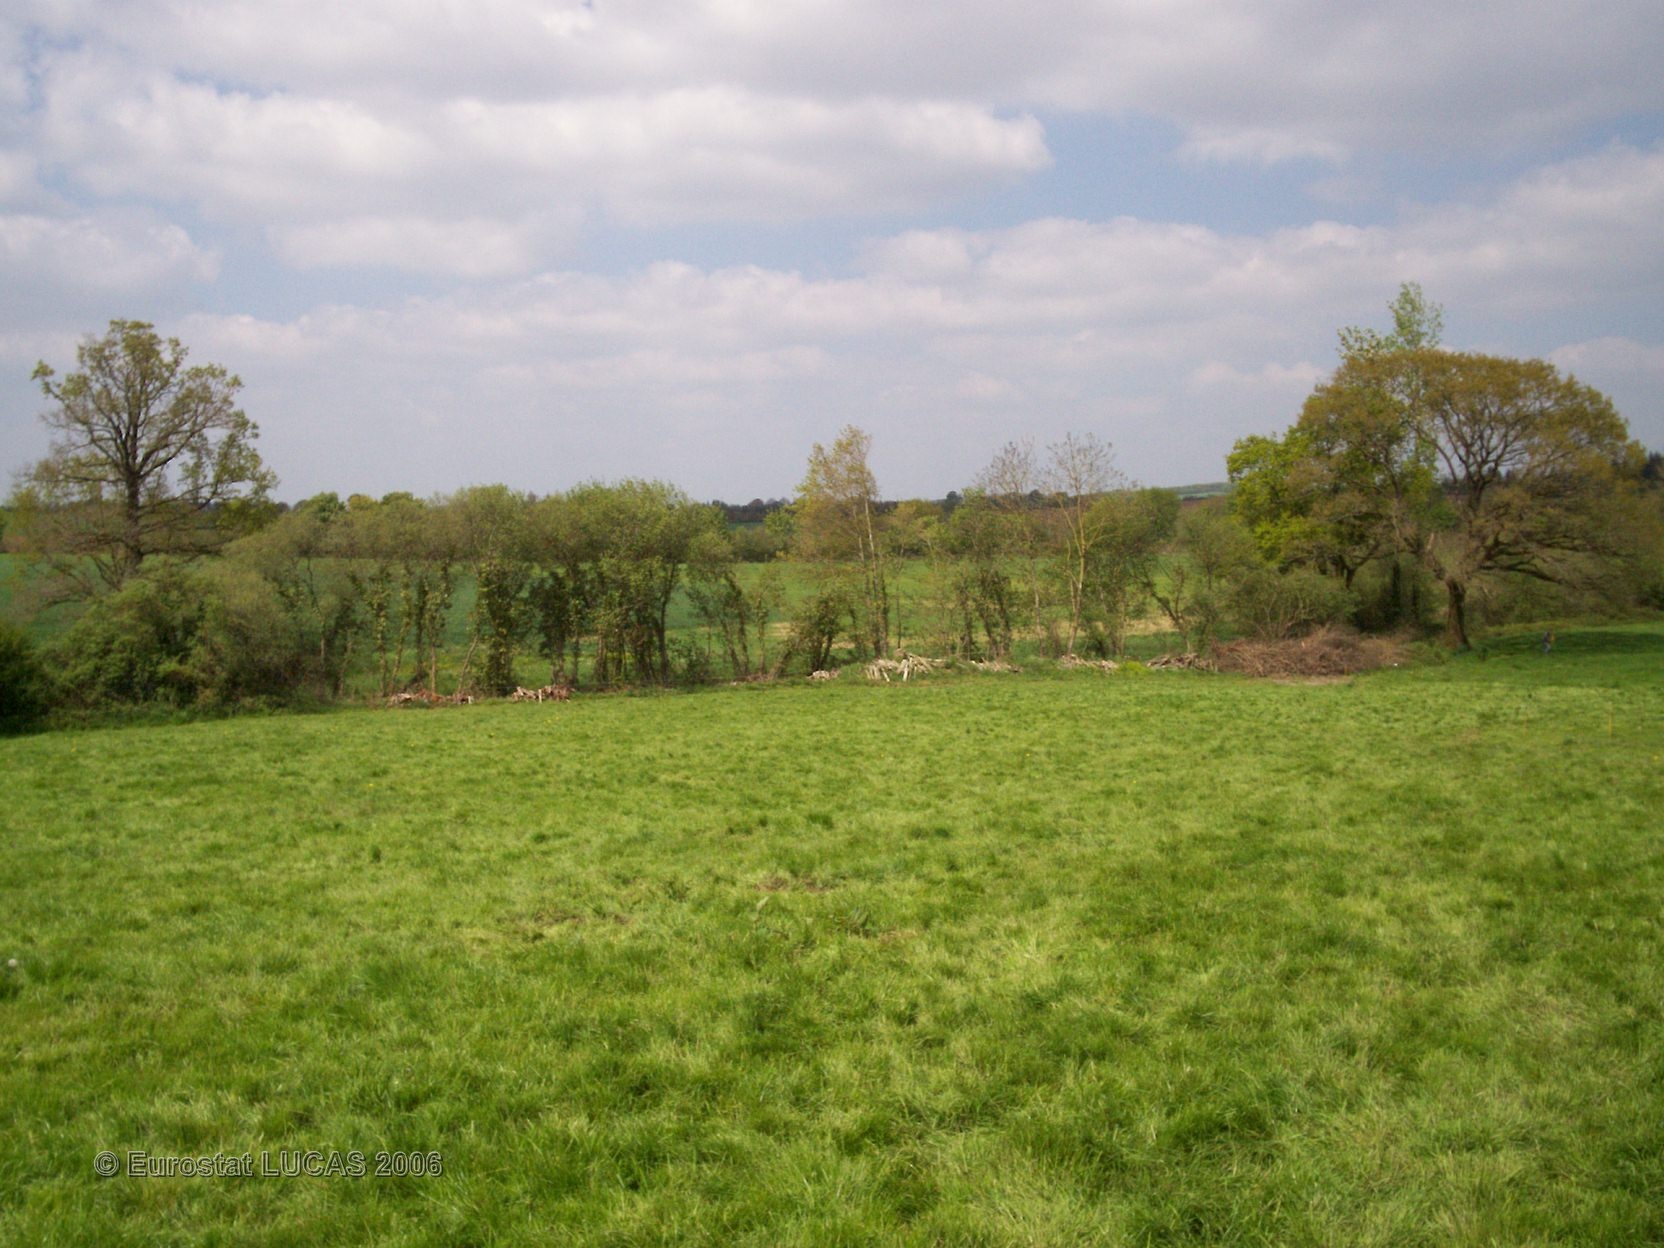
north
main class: Grassland
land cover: Grassland without tree/shrub cover
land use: Agriculture (excluding fallow land and kitchen gardens)
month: May
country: FR
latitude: 48.3523
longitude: -3.6706
